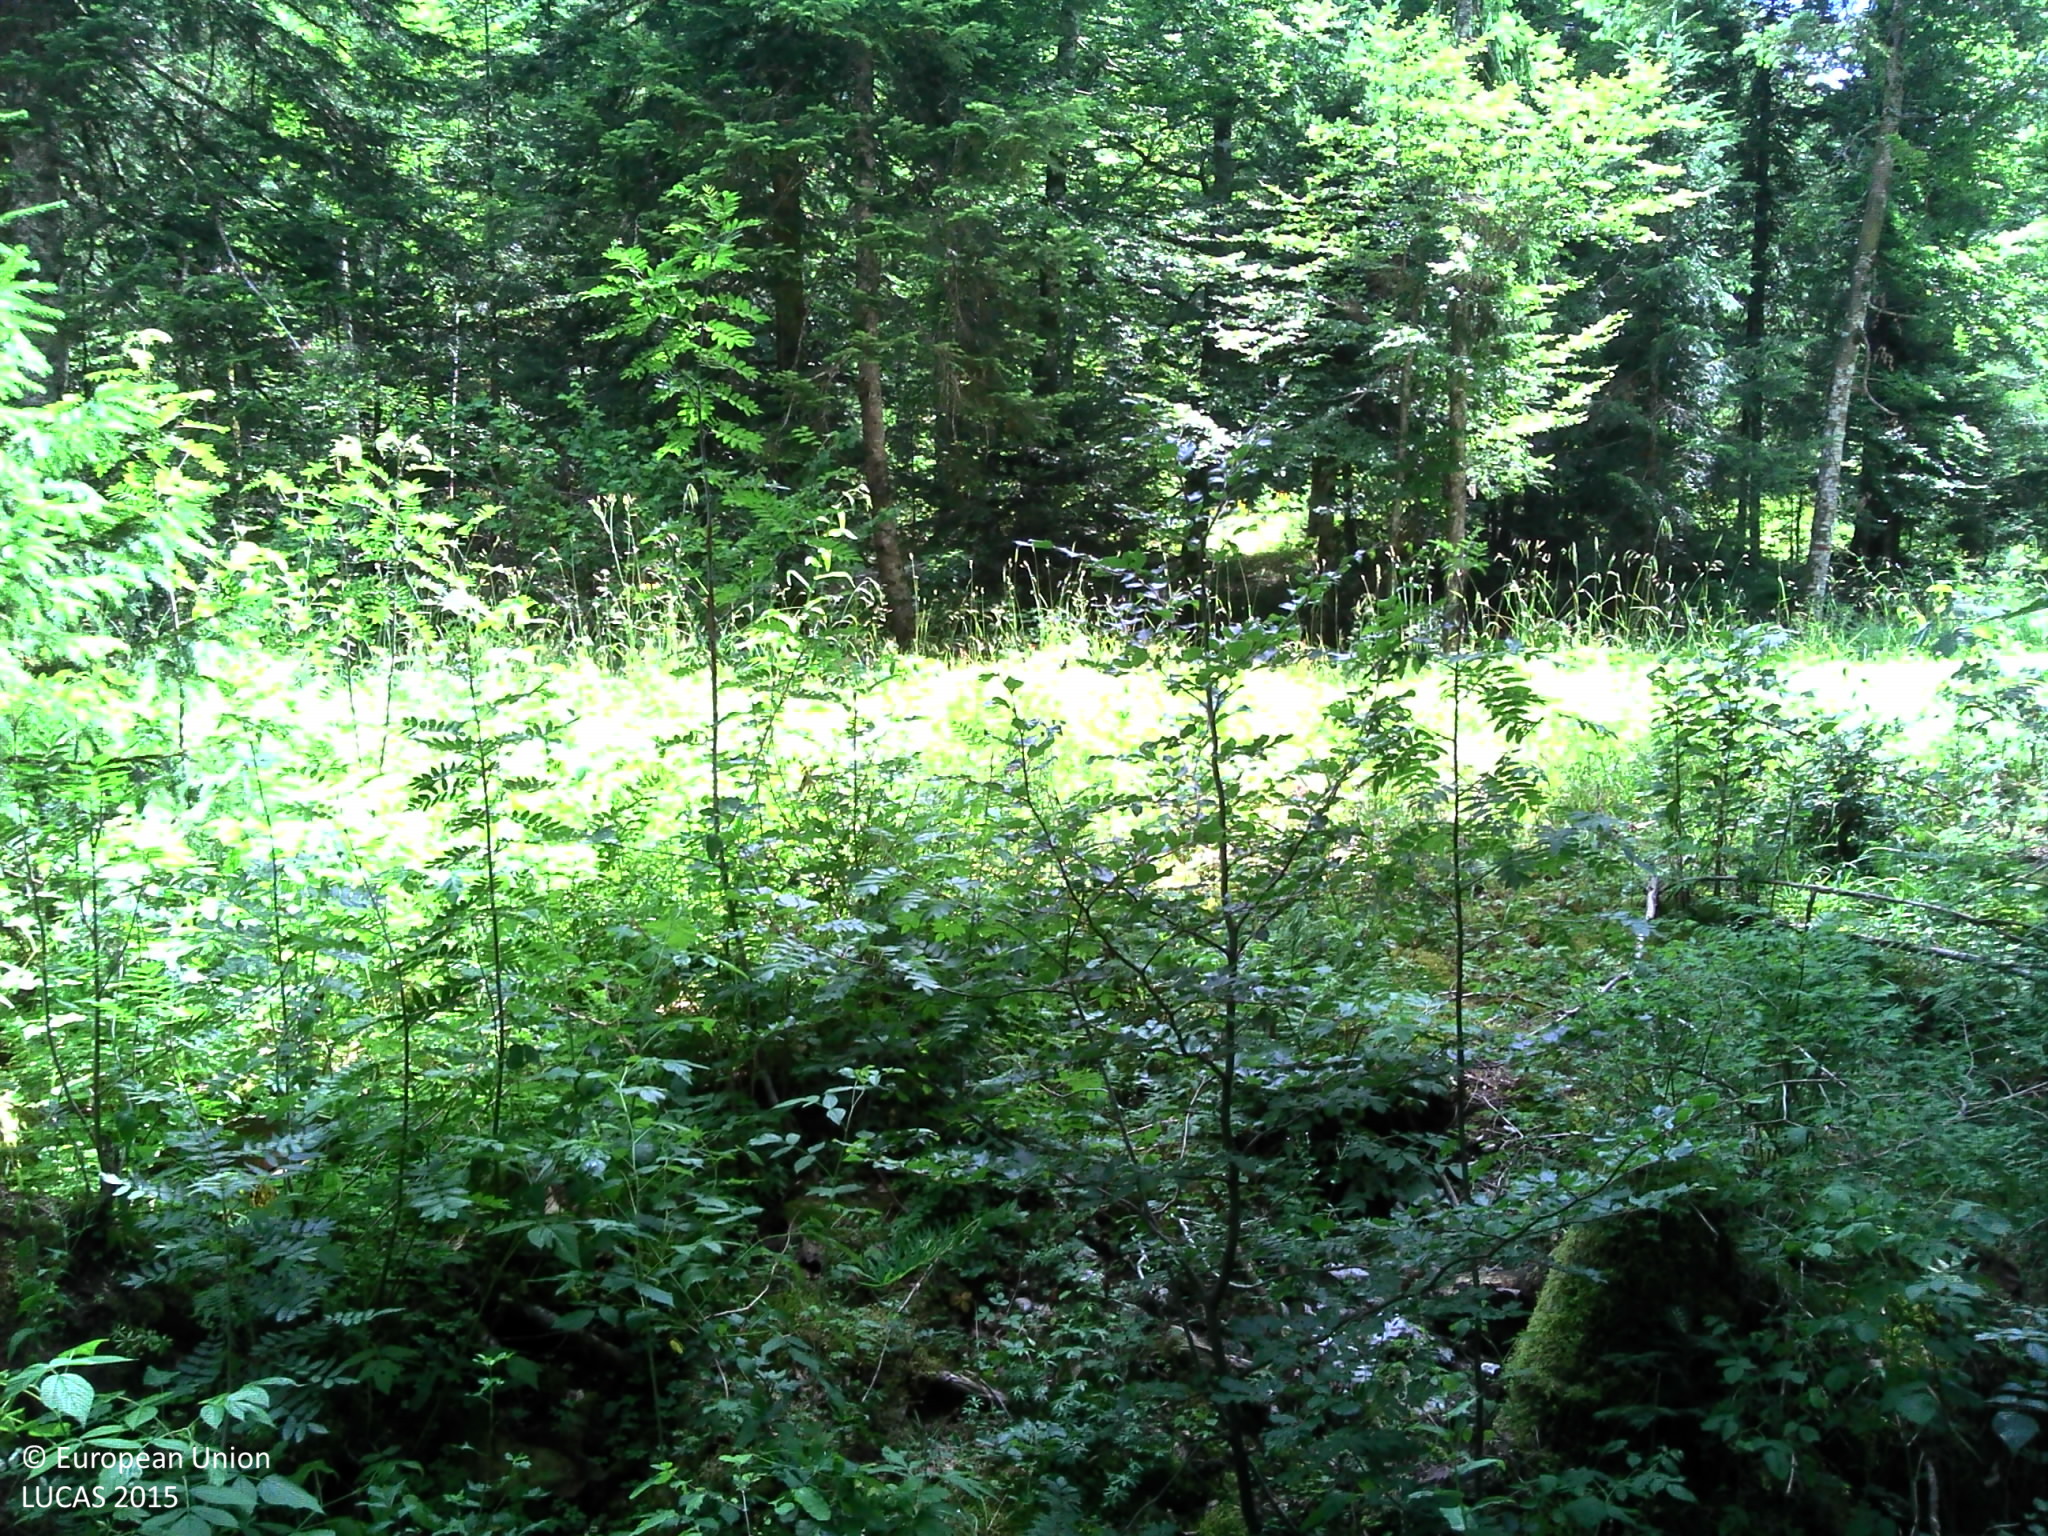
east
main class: Woodland
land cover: Other mixed woodland
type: mountainous beech forest
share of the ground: > 75 %
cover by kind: coniferous forest trees 30 %, broadleaved forest trees 30 %, lichens and mosses 15 %, consolidated bare surface 15 %, herbaceous plants 10 %
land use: Forestry
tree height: > 5 m
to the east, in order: Other mixed woodland; Grass margins; Tracks; Grass margins; Other mixed woodland
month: July
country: FR
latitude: 46.7513
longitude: 6.1670
